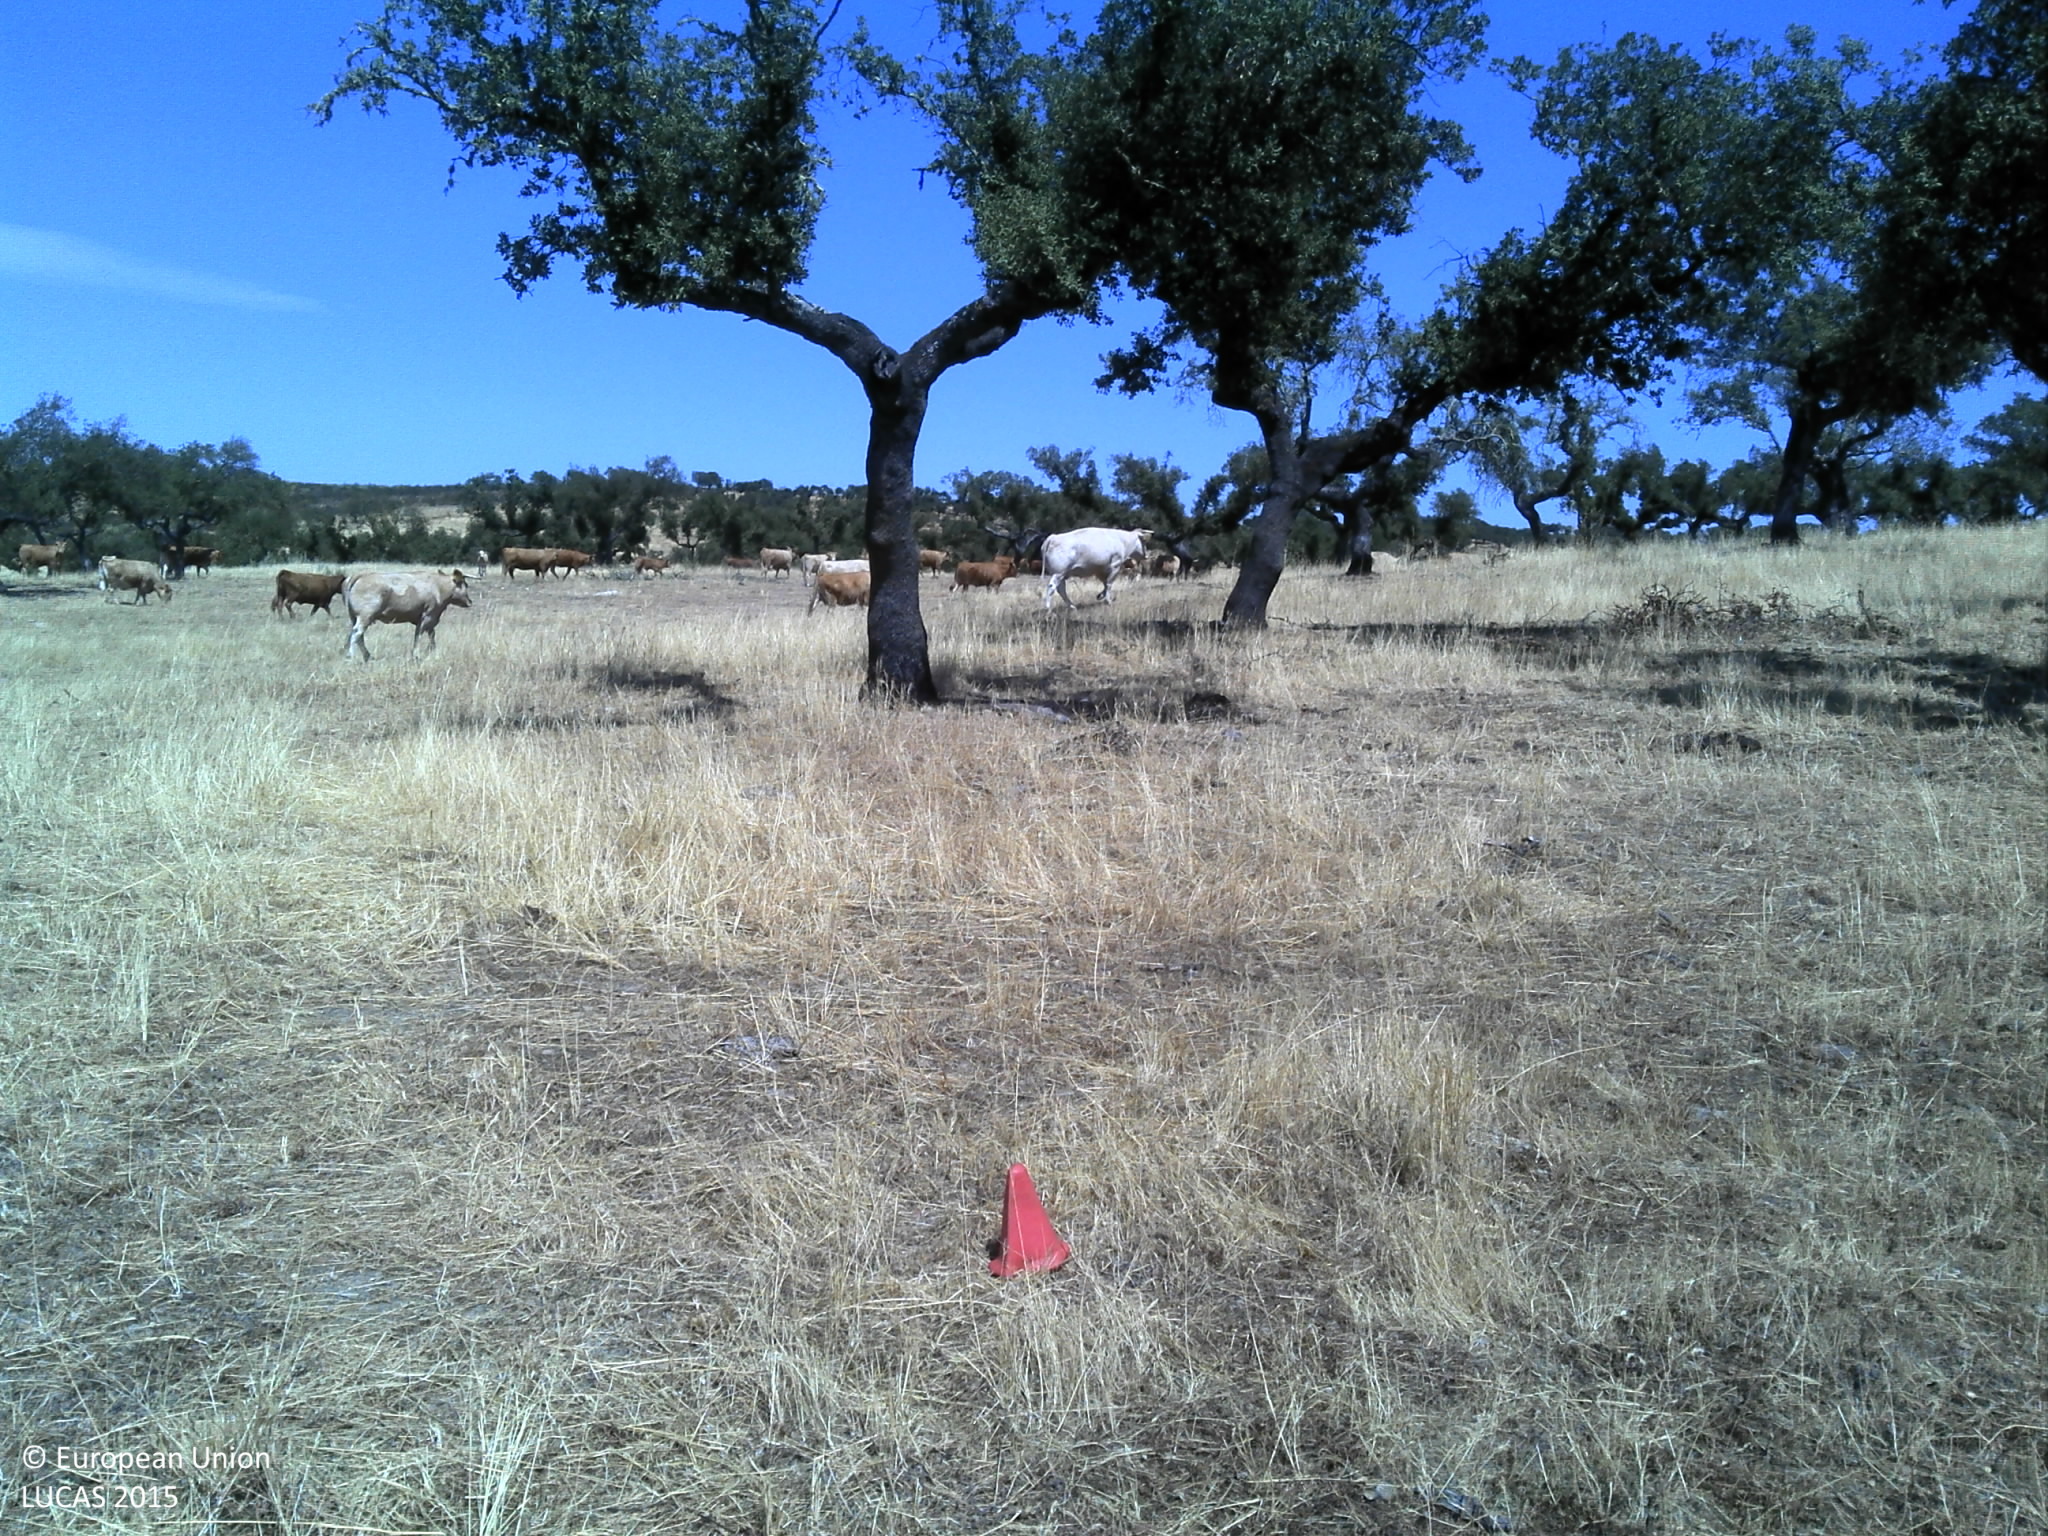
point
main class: Woodland
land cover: Broadleaved woodland
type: broadleaved evergreen forest
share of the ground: 50 - 75 %
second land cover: Grassland without tree/shrub cover
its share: 50 - 75 %
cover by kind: broadleaved forest trees 70 %, herbaceous plants 30 %
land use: Forestry
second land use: Agriculture (excluding fallow land and kitchen gardens)
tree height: > 5 m
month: July
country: PT
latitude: 38.3272
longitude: -7.2119
